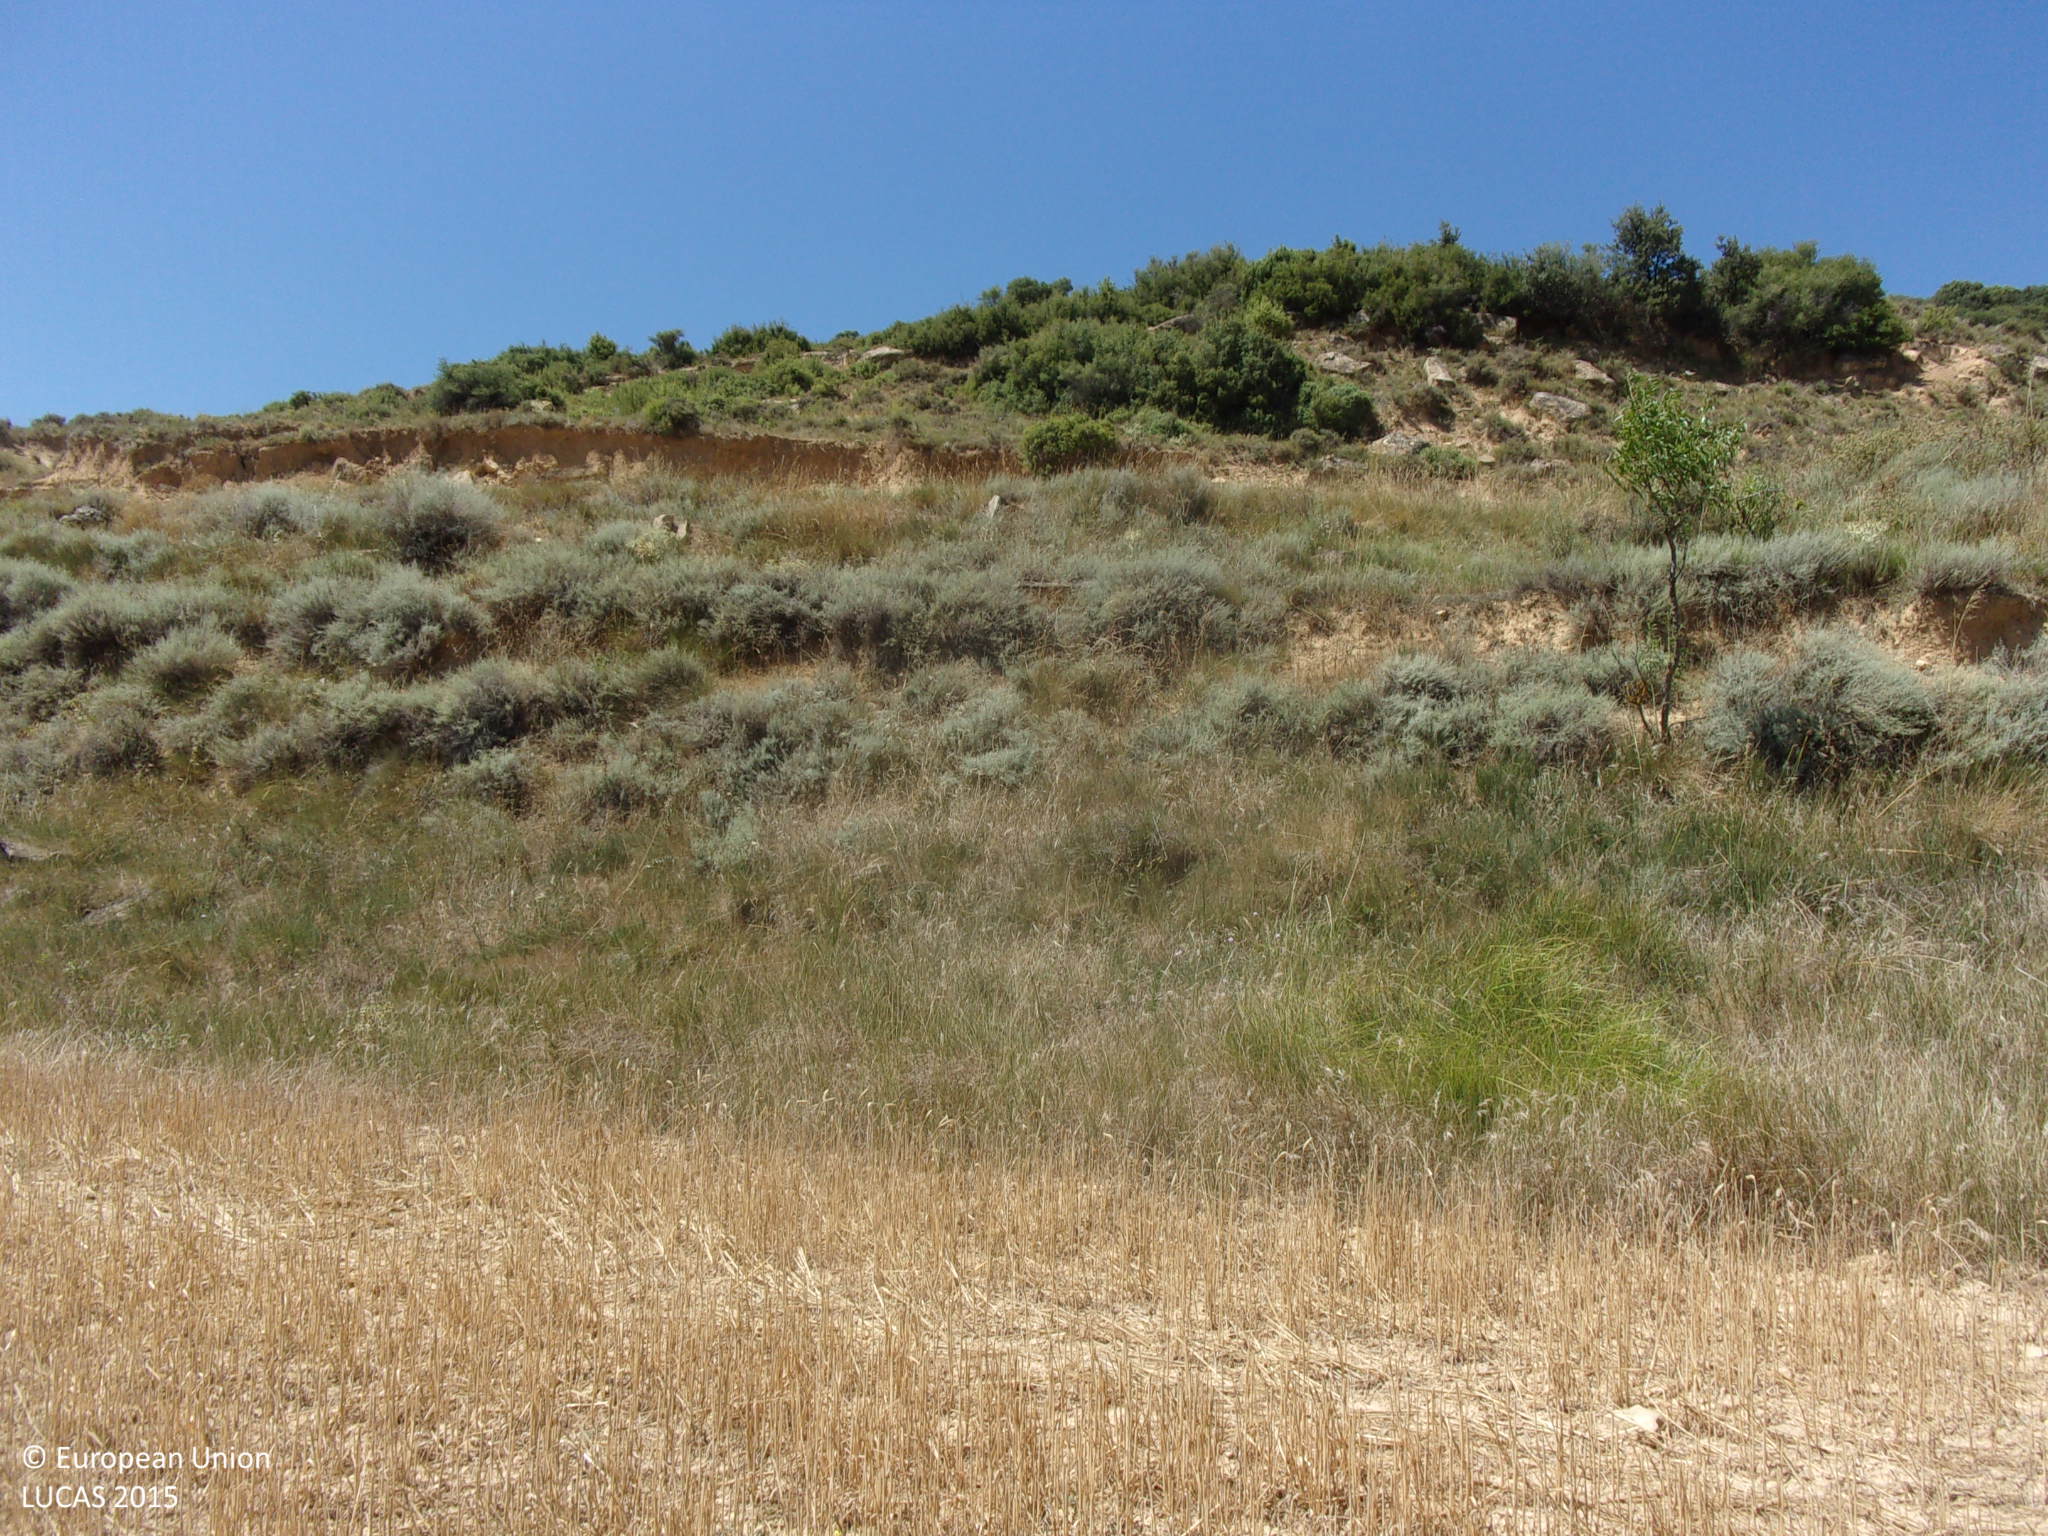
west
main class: Cropland
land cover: Common wheat
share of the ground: < 10 %
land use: Agriculture (excluding fallow land and kitchen gardens)
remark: Harvested field
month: August
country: ES
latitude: 42.3448
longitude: -1.1614
